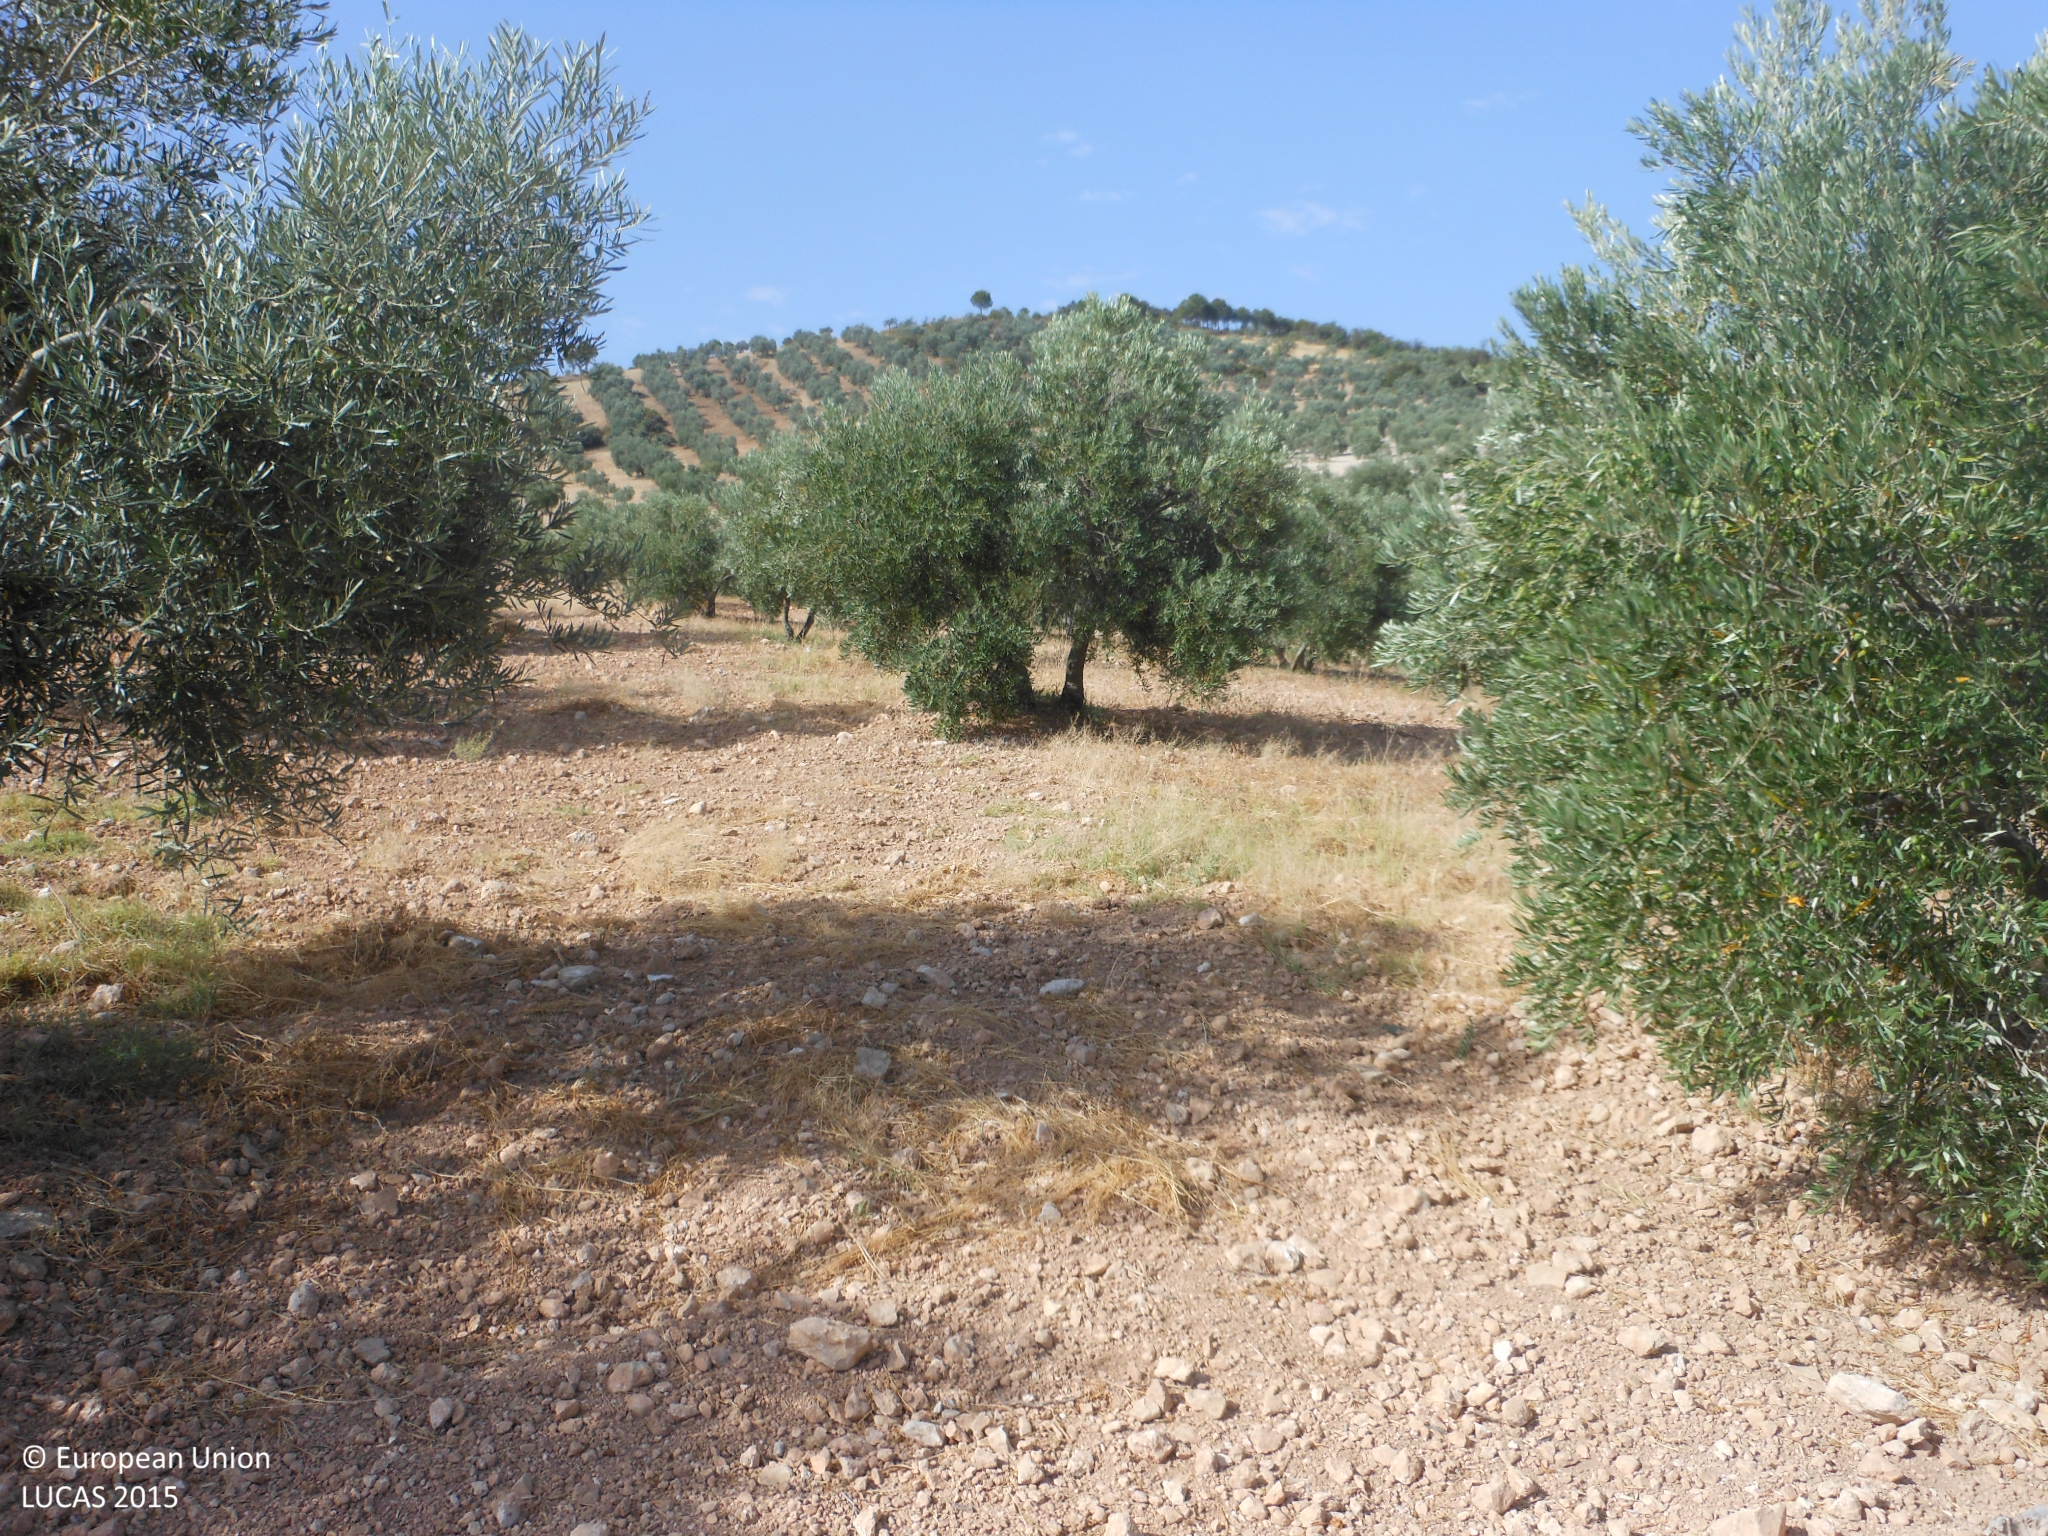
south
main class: Cropland
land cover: Olive groves
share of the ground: 25 - 50 %
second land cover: Other bare soil
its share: > 75 %
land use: Agriculture (excluding fallow land and kitchen gardens)
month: July
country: ES
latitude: 37.0987
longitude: -5.0248
